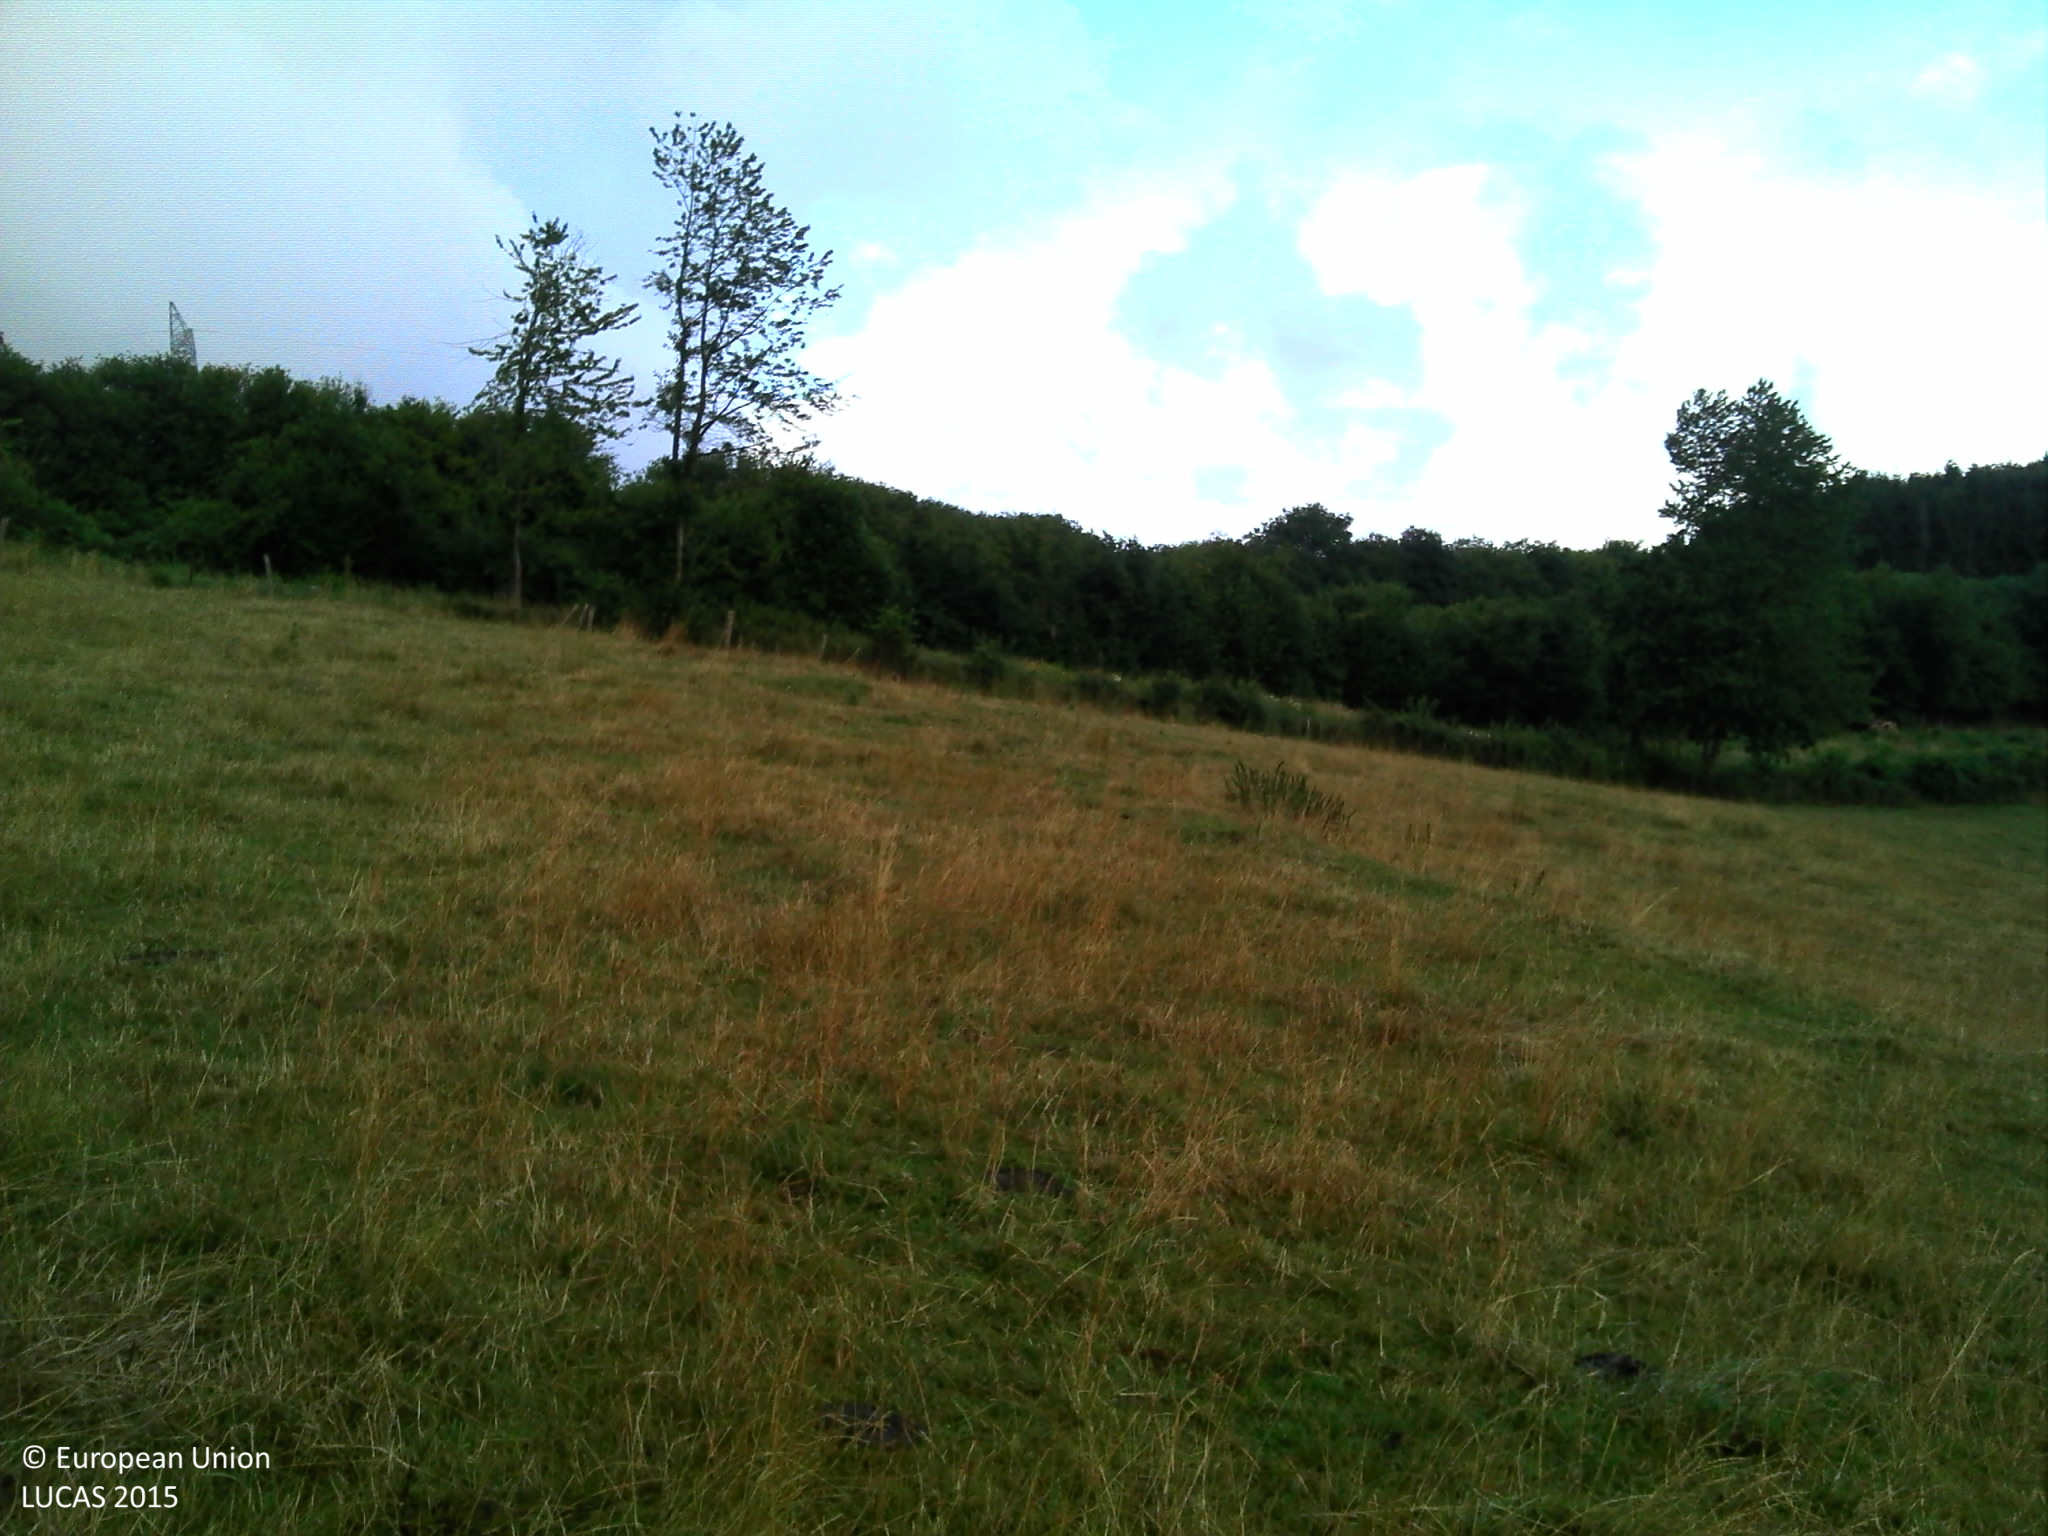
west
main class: Grassland
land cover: Grassland without tree/shrub cover
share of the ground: > 75 %
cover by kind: herbaceous plants 100 %
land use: Agriculture (excluding fallow land and kitchen gardens)
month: July
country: BE
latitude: 49.6019
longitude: 5.7787
